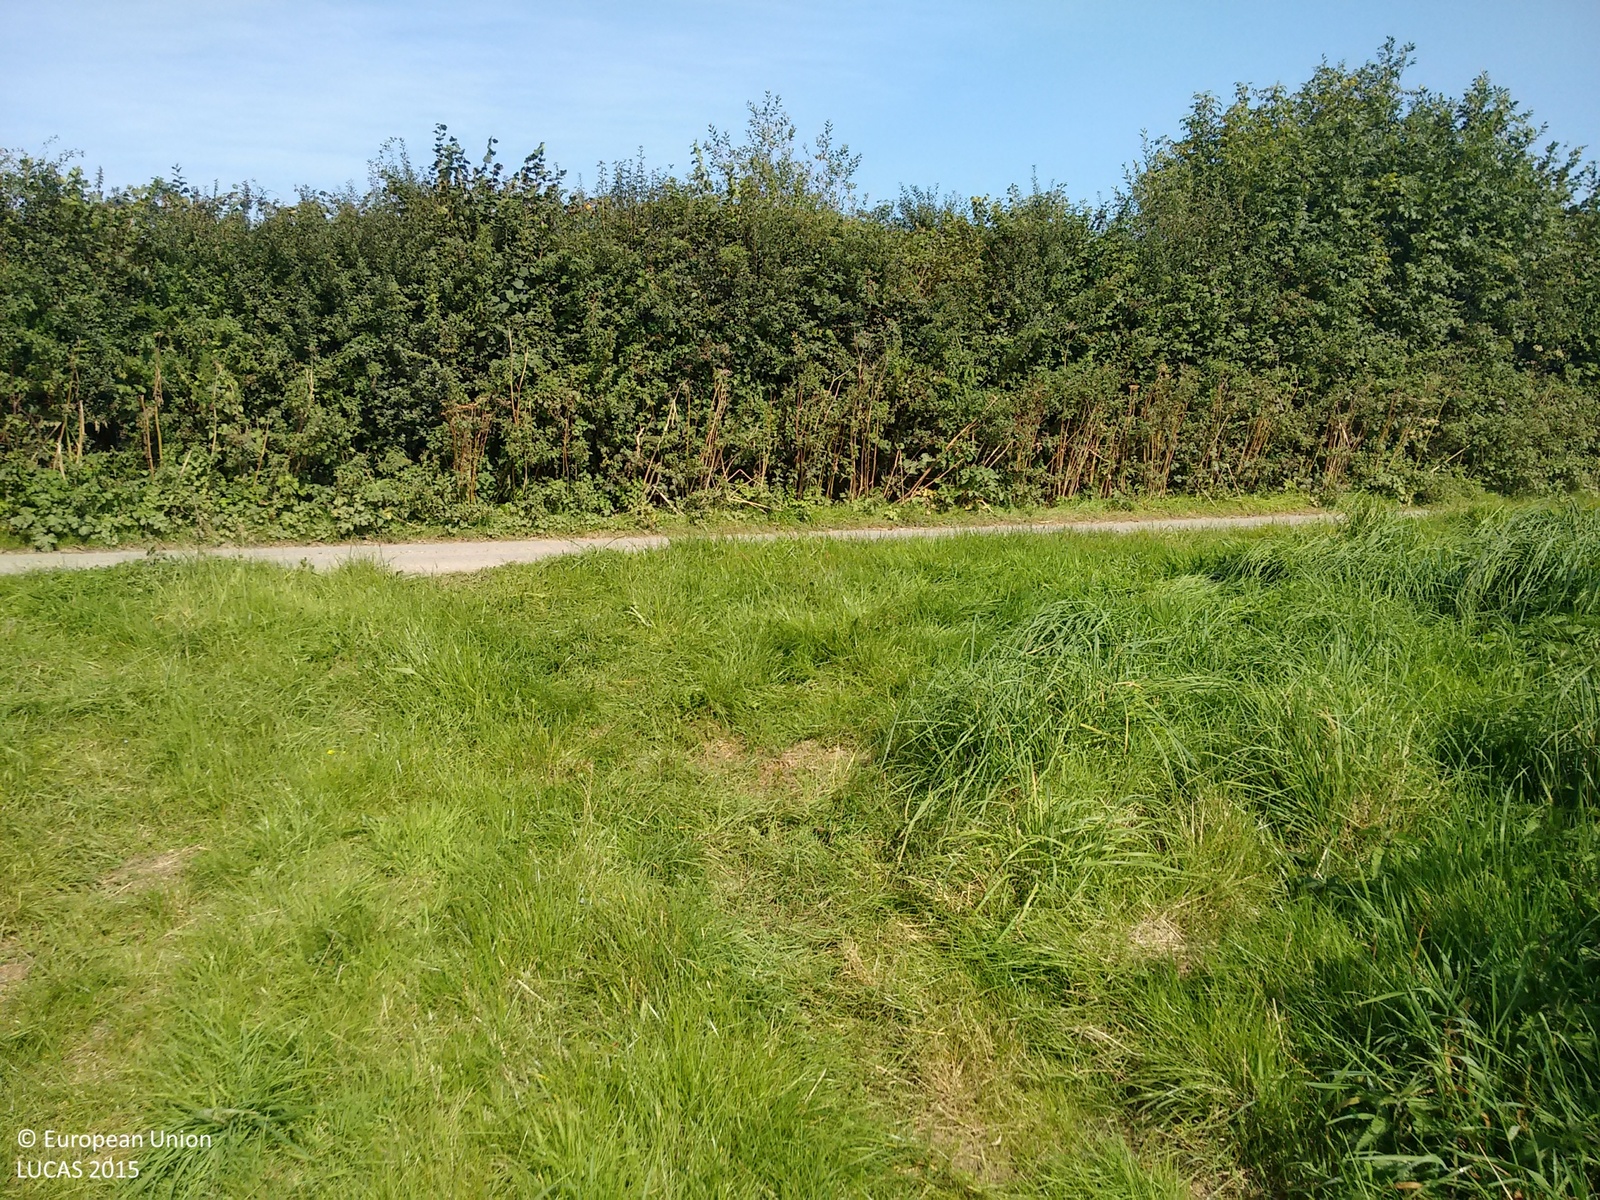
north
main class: Grassland
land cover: Grassland without tree/shrub cover
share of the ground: > 75 %
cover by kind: herbaceous plants 100 %
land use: Agriculture (excluding fallow land and kitchen gardens)
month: September
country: GB
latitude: 50.8281
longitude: -4.3121
